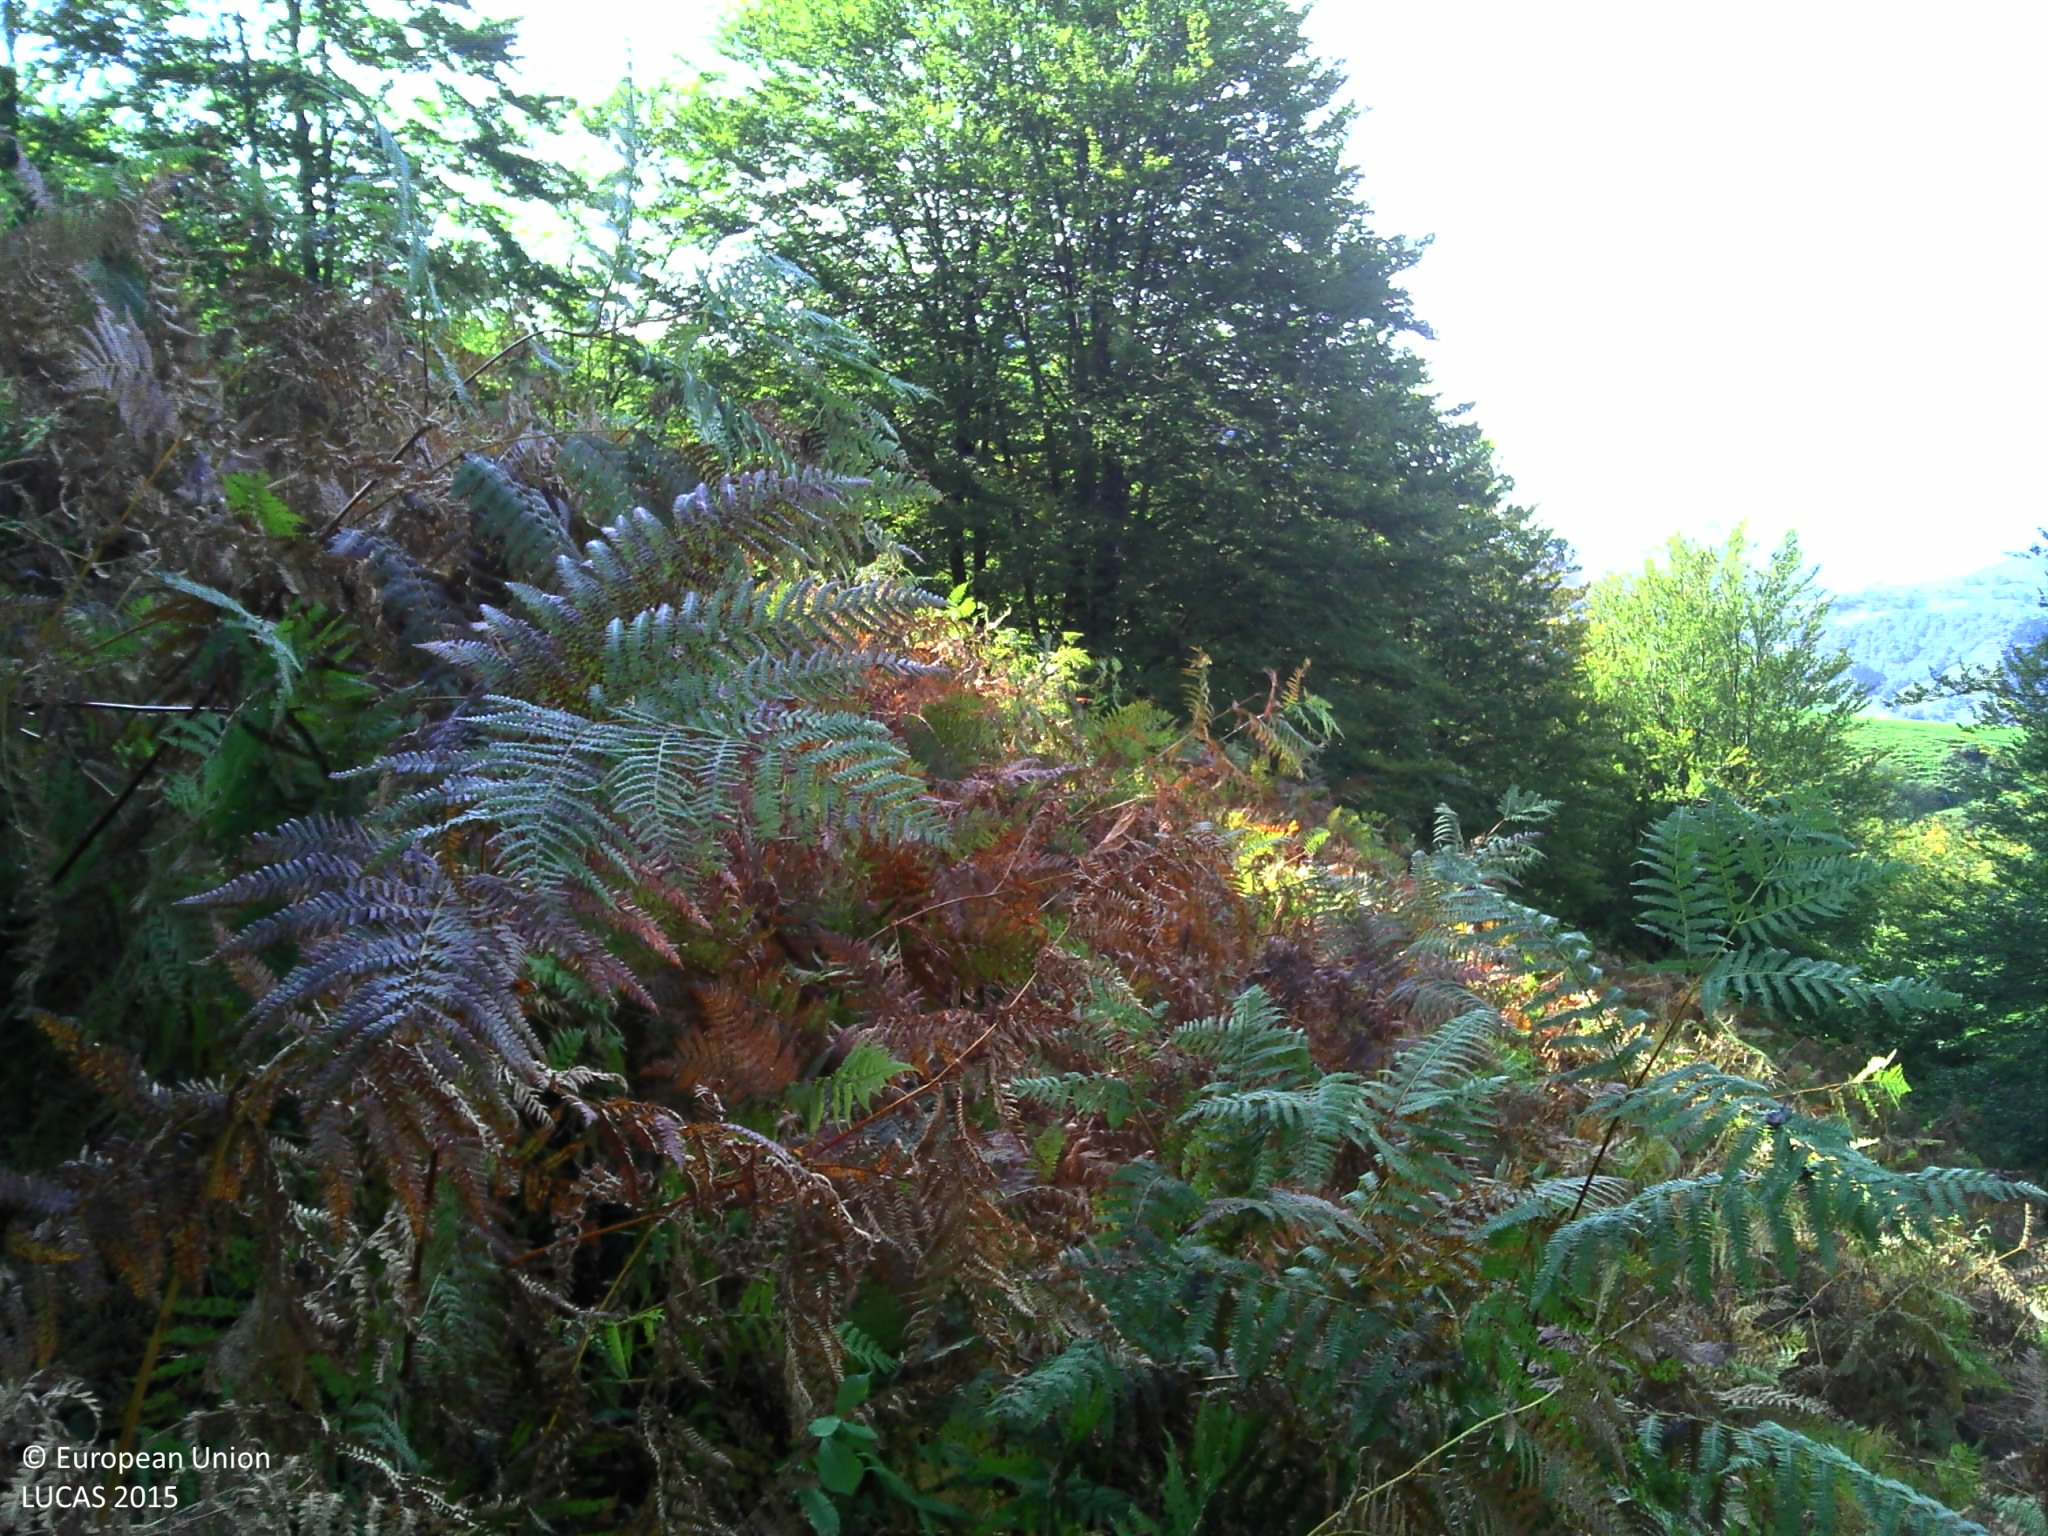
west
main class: Grassland
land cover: Spontaneously vegetated surfaces
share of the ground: > 75 %
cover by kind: herbaceous plants 95 %, shrubs 5 %
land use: Abandoned areas
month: September
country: FR
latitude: 43.0373
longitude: -0.6488
